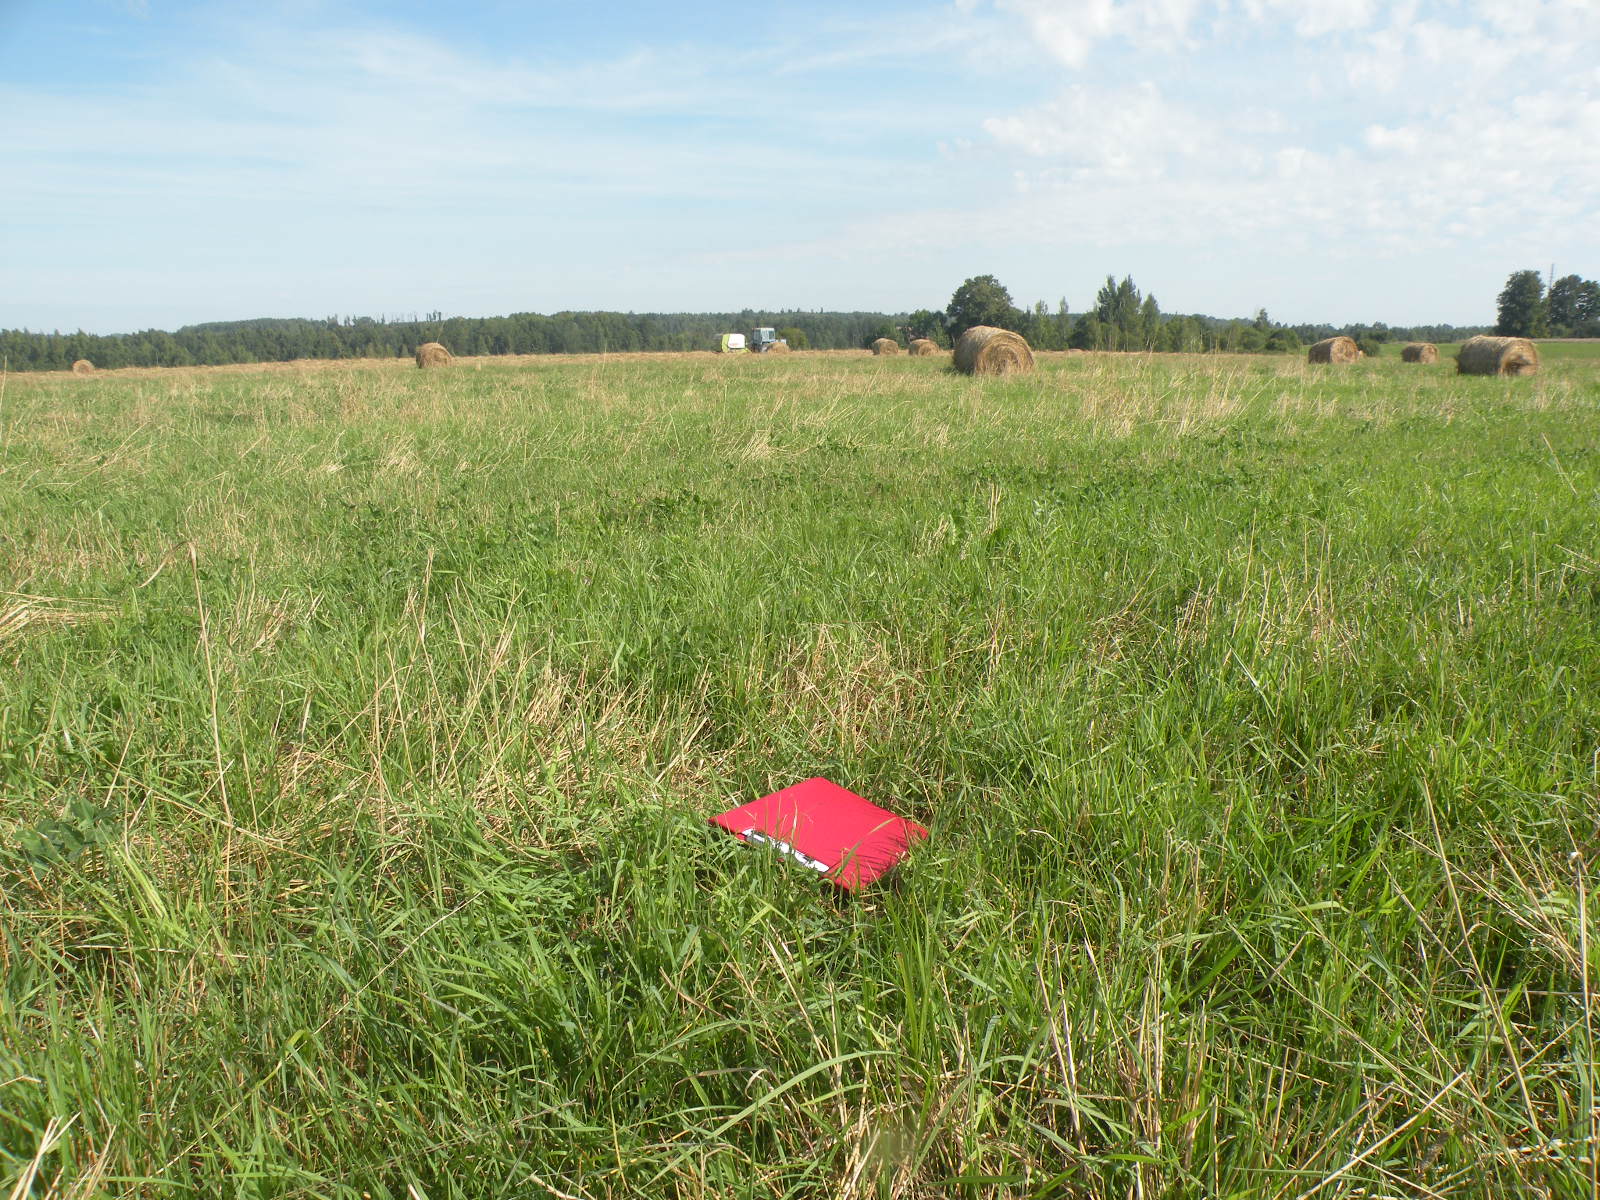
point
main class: Grassland
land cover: Grassland without tree/shrub cover
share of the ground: > 75 %
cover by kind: herbaceous plants 100 %
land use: Agriculture (excluding fallow land and kitchen gardens)
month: August
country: LV
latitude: 55.9387
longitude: 26.1991
